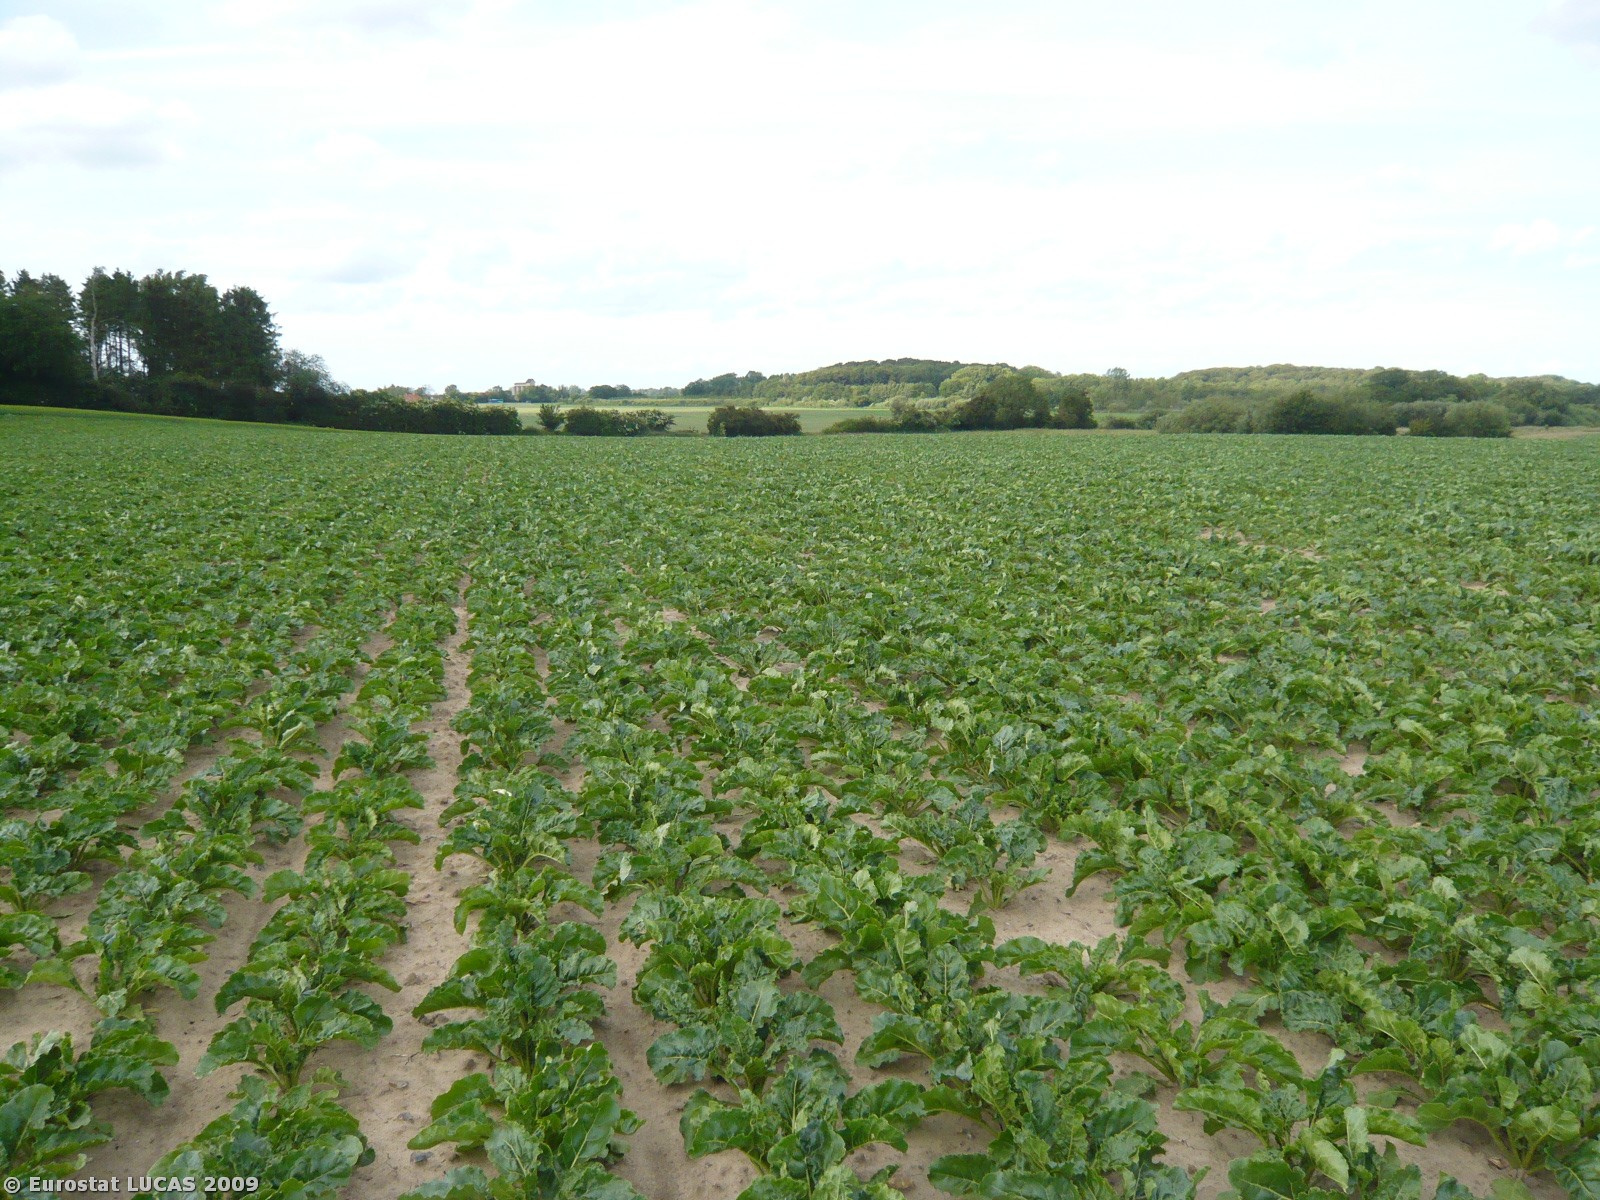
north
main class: Cropland
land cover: Sugar beet
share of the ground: > 75 %
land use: Agriculture (excluding fallow land and kitchen gardens)
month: June
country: DK
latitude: 54.7591
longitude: 11.4753
